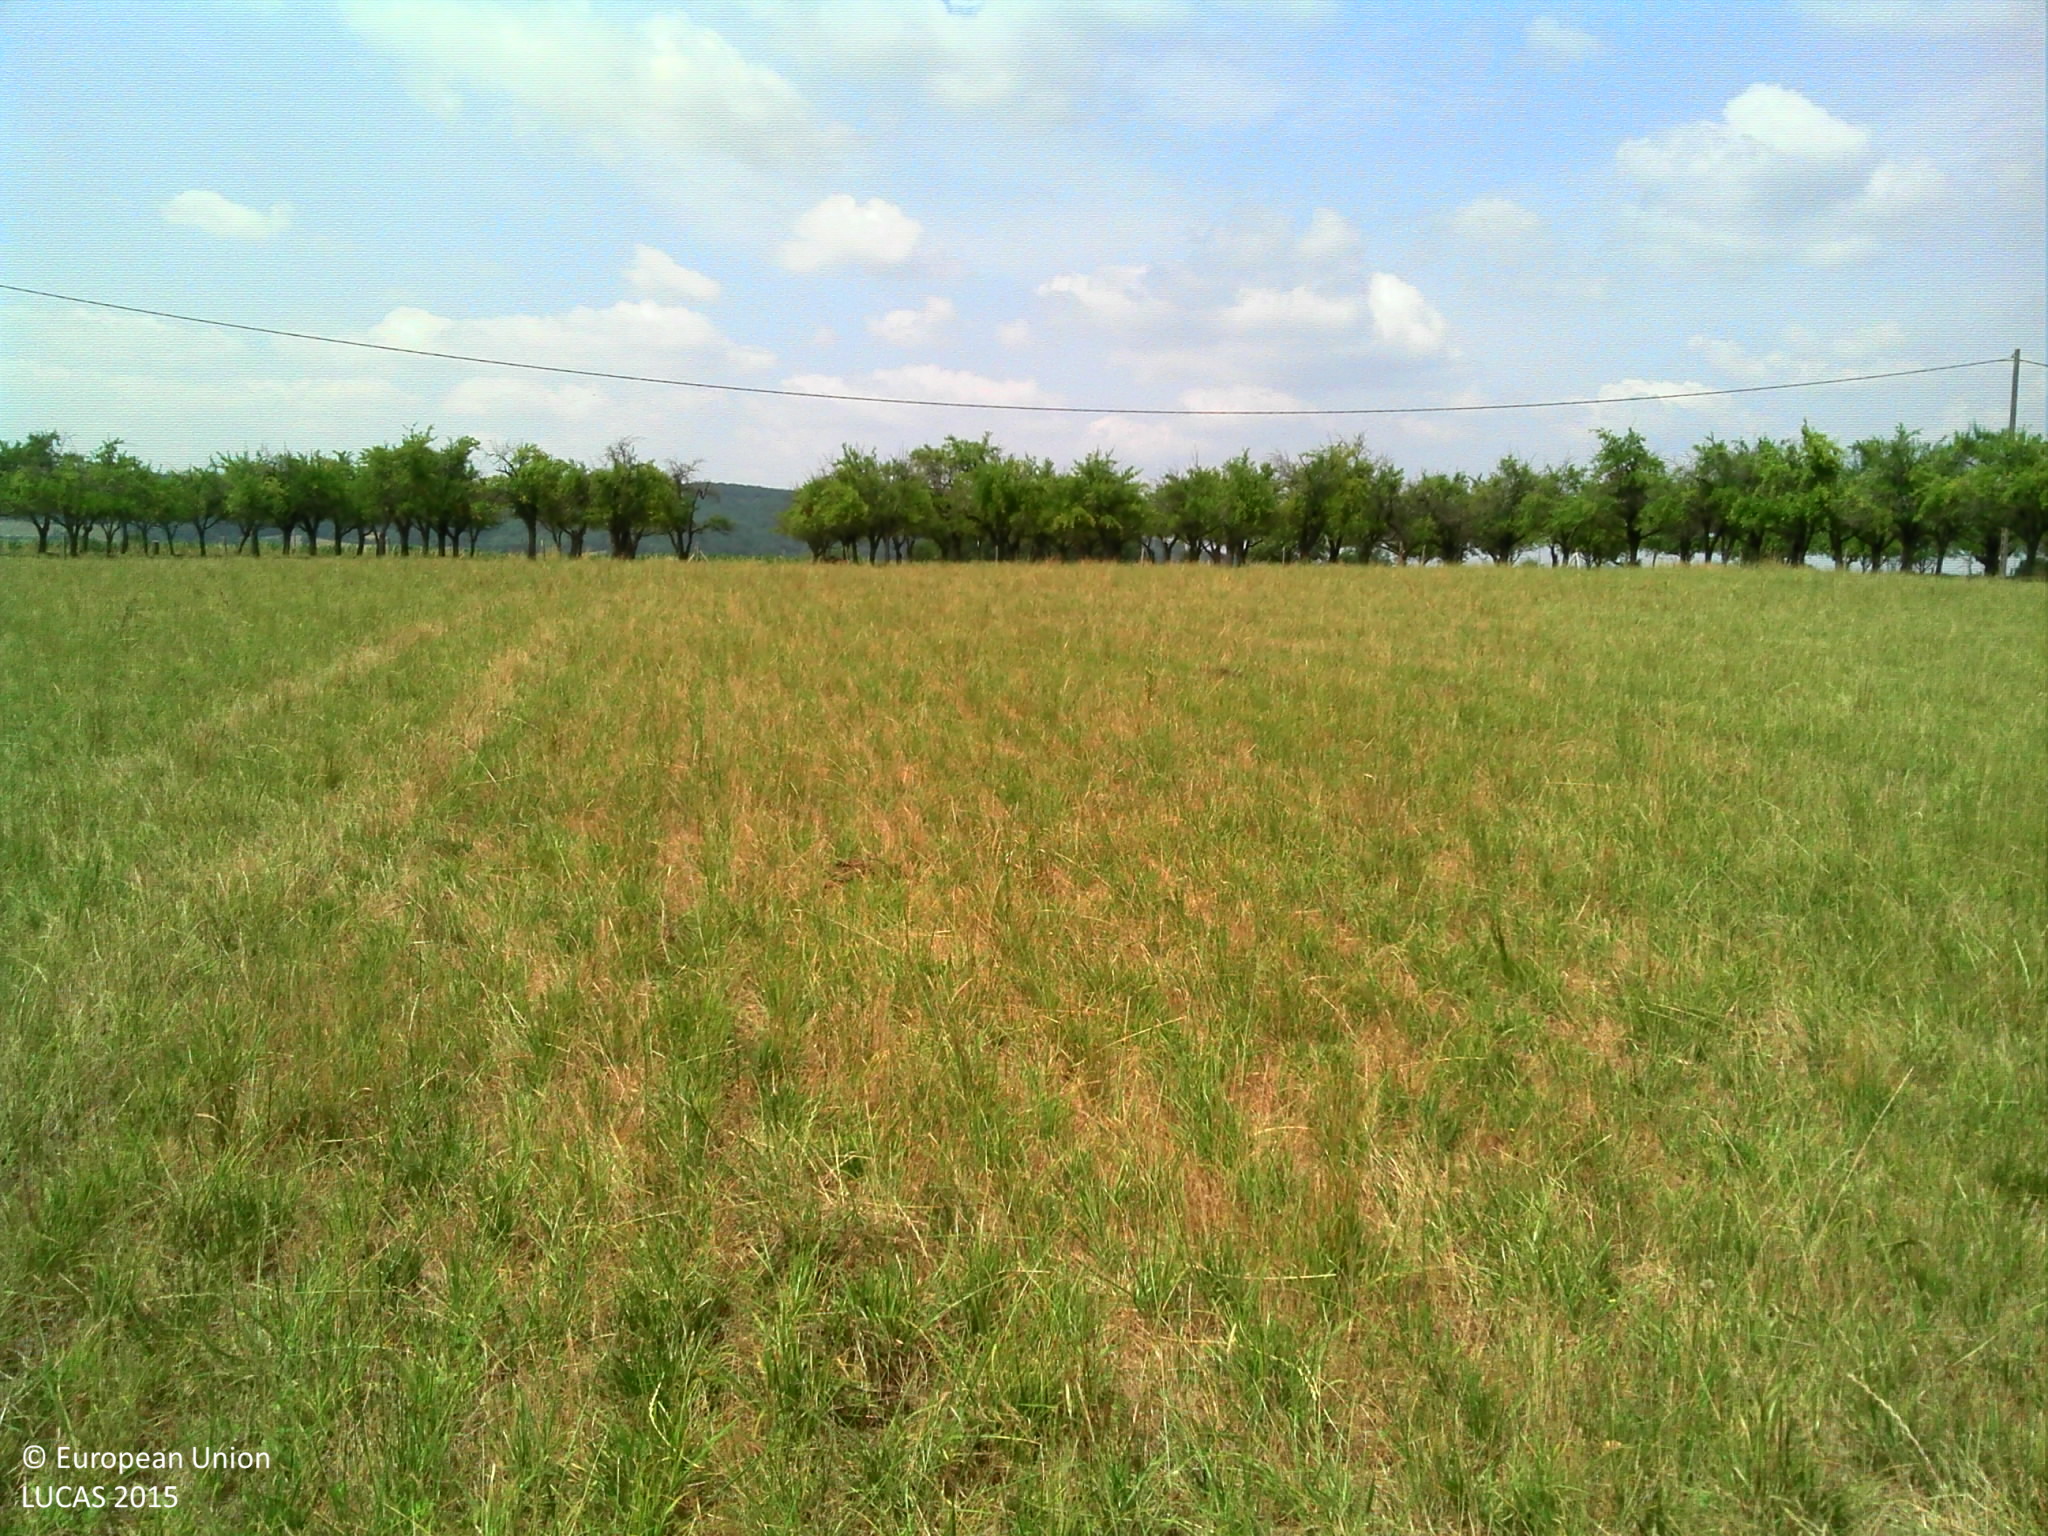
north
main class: Grassland
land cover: Grassland without tree/shrub cover
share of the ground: > 75 %
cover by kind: herbaceous plants 100 %
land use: Agriculture (excluding fallow land and kitchen gardens)
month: July
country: FR
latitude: 44.4185
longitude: 0.8643
